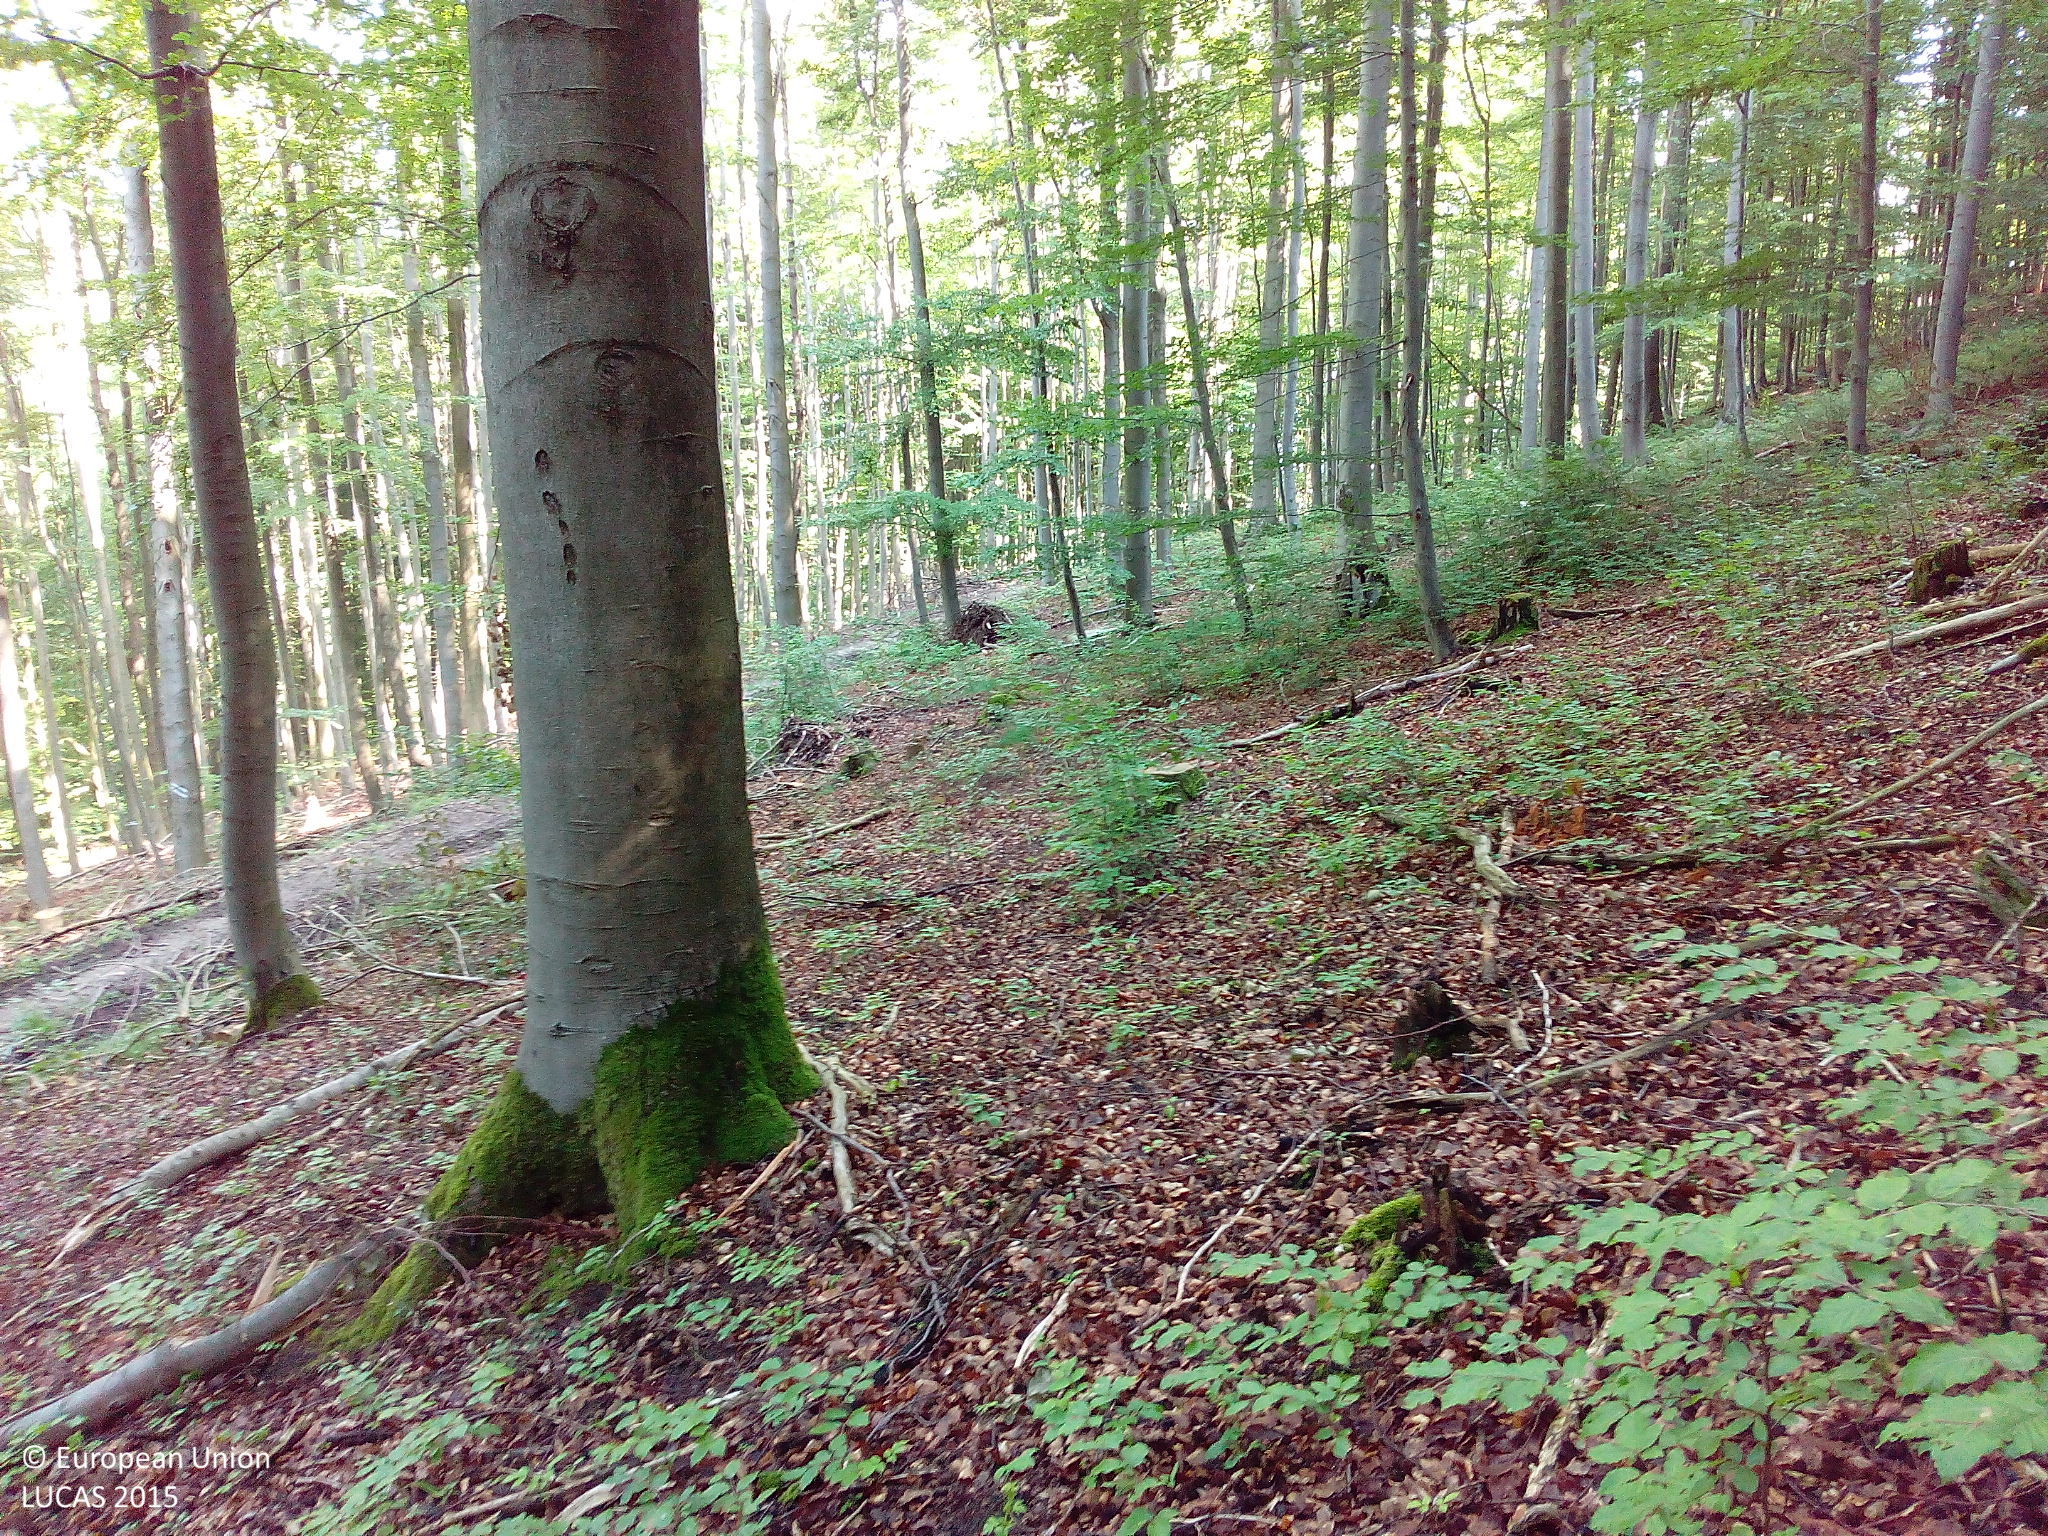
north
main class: Woodland
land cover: Broadleaved woodland
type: beech forest
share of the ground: > 75 %
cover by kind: broadleaved forest trees 100 %
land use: Forestry
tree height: > 5 m
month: July
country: DE
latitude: 50.6337
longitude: 9.9293
